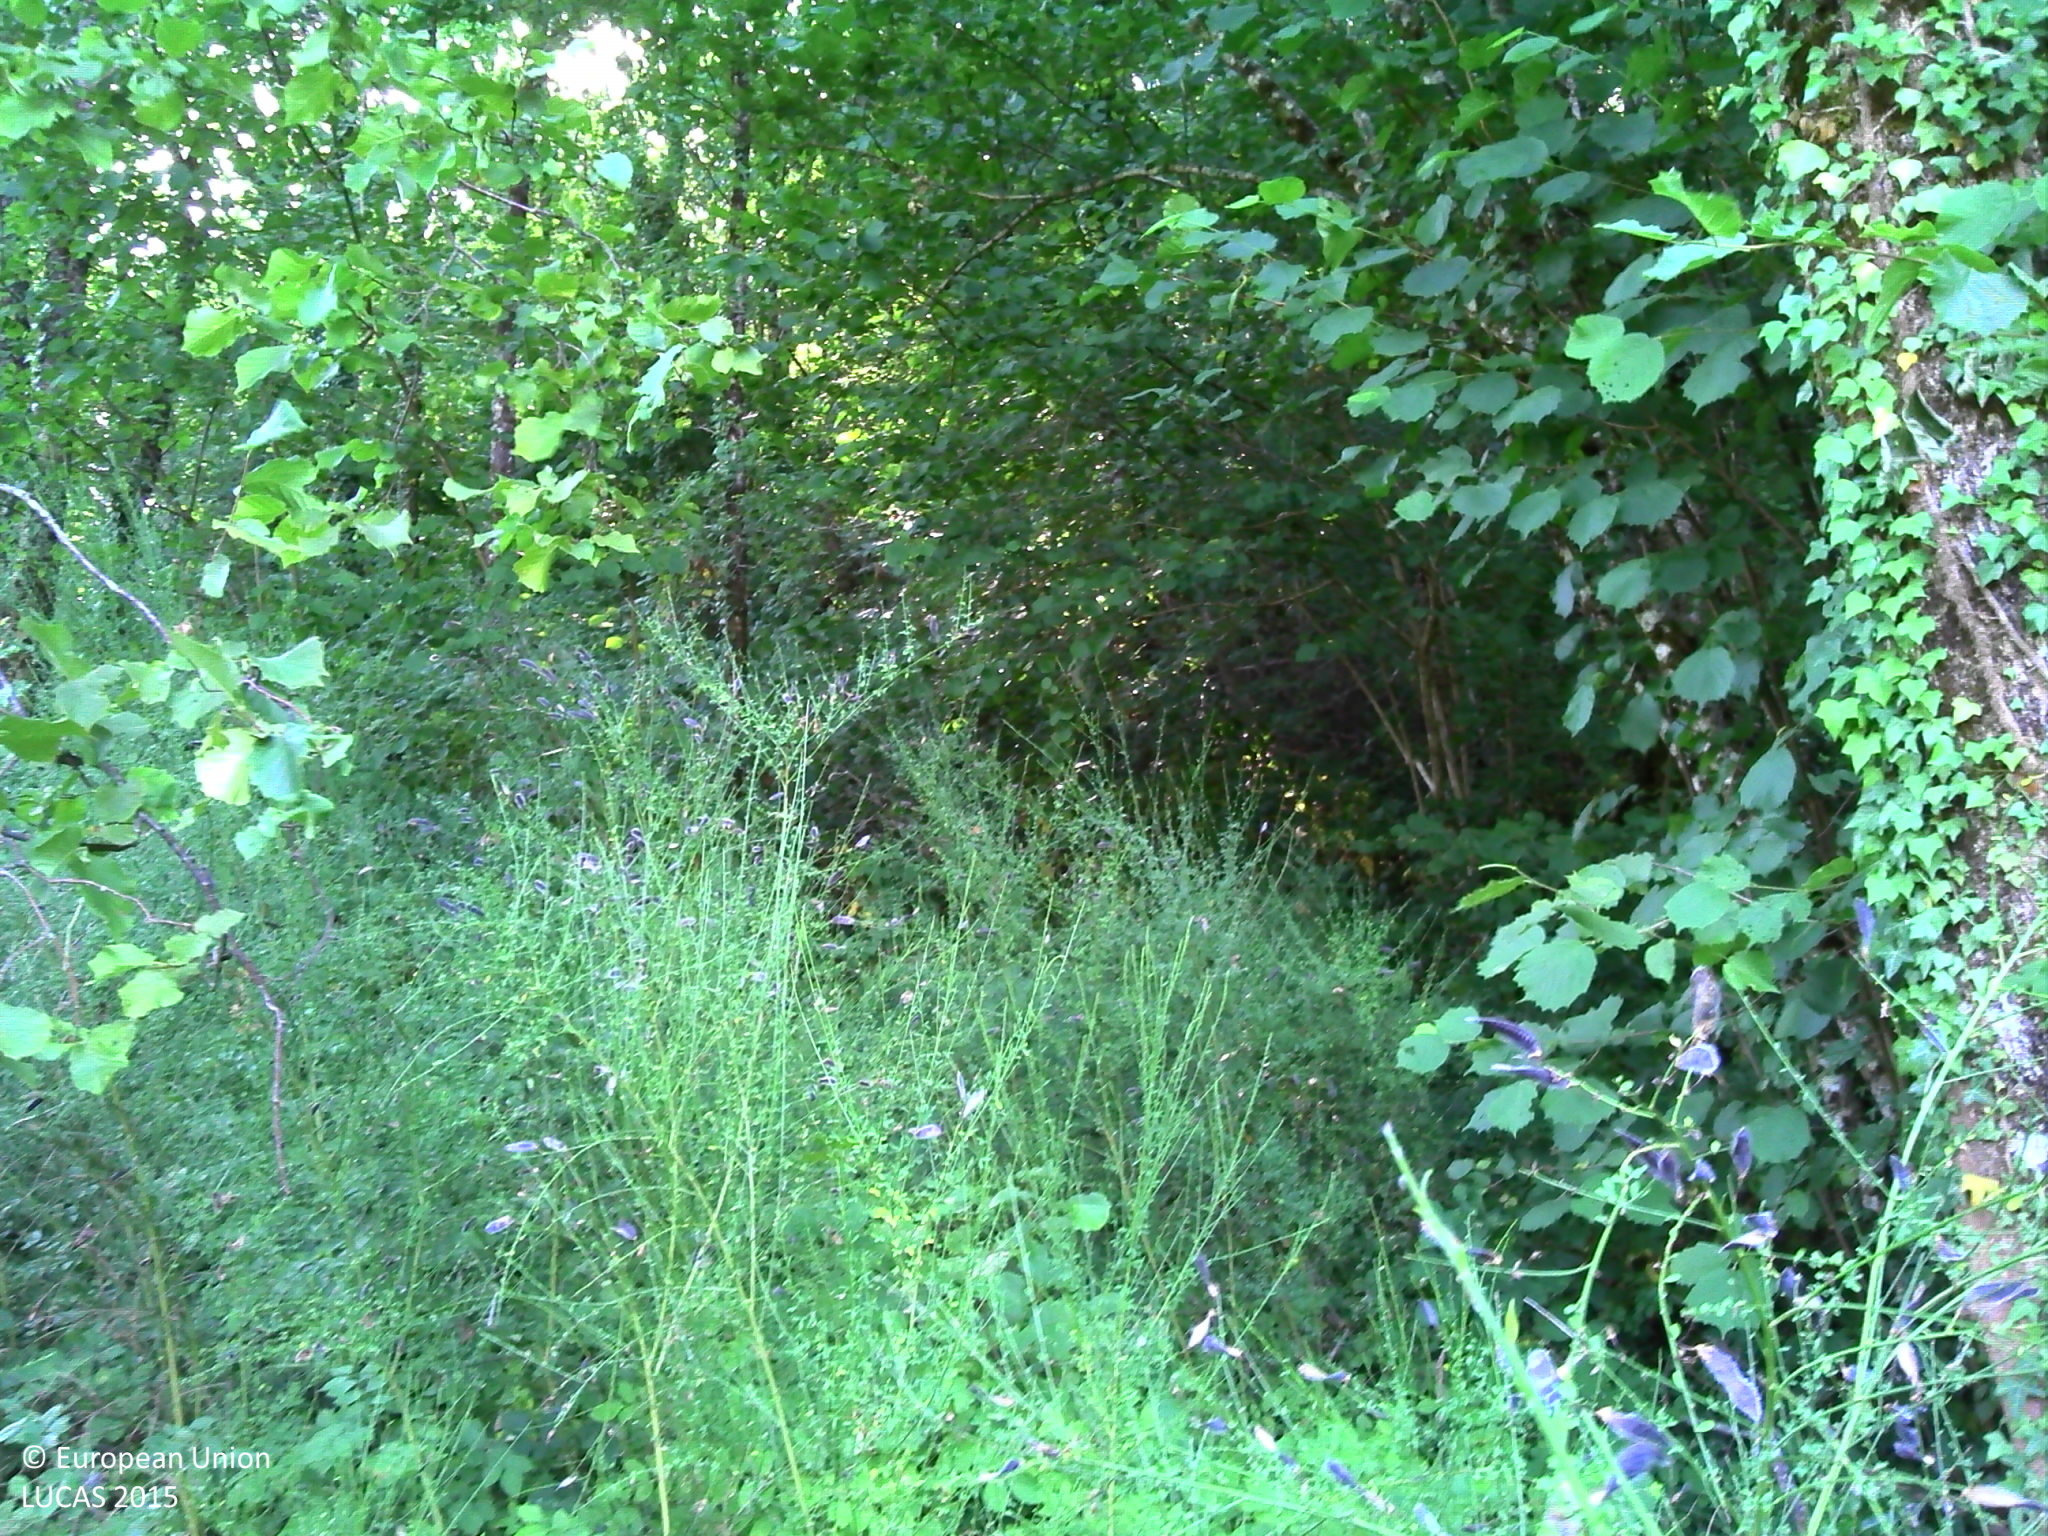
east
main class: Woodland
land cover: Broadleaved woodland
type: acidophilous oak and oak-birch forest
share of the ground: > 75 %
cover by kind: broadleaved forest trees 75 %, shrubs 20 %, herbaceous plants 5 %
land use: Forestry
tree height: > 5 m
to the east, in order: Broadleaved woodland
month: July
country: FR
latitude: 44.4940
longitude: 2.9994
